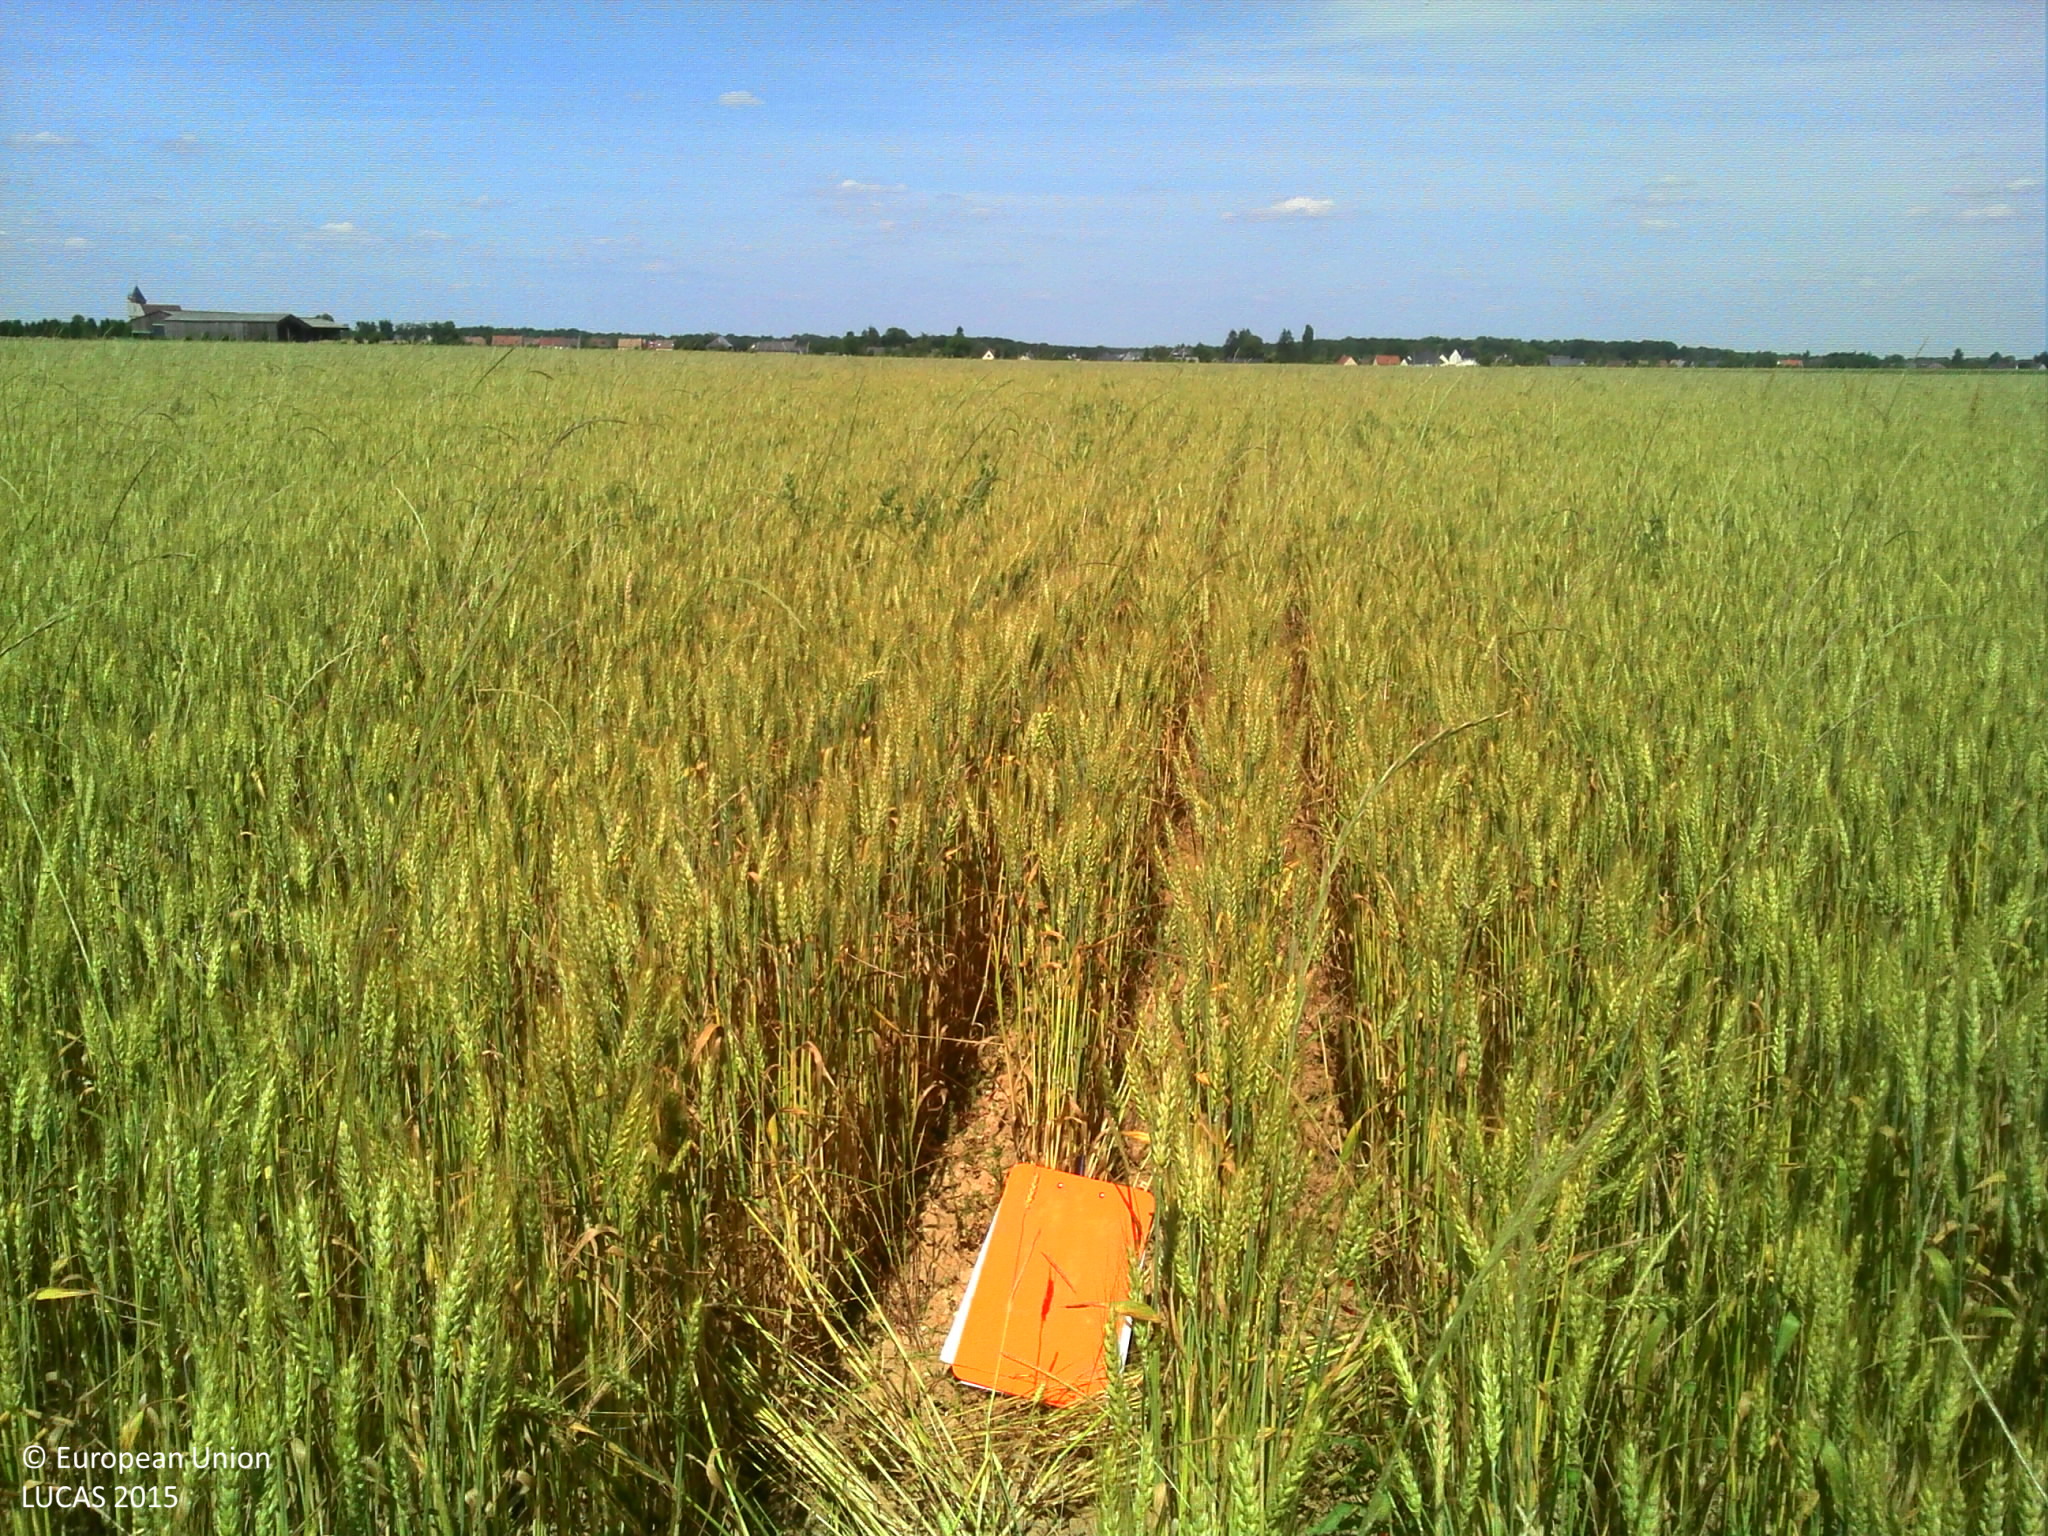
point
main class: Cropland
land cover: Common wheat
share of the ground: > 75 %
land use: Agriculture (excluding fallow land and kitchen gardens)
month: June
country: FR
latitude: 49.0730
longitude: 1.0673
